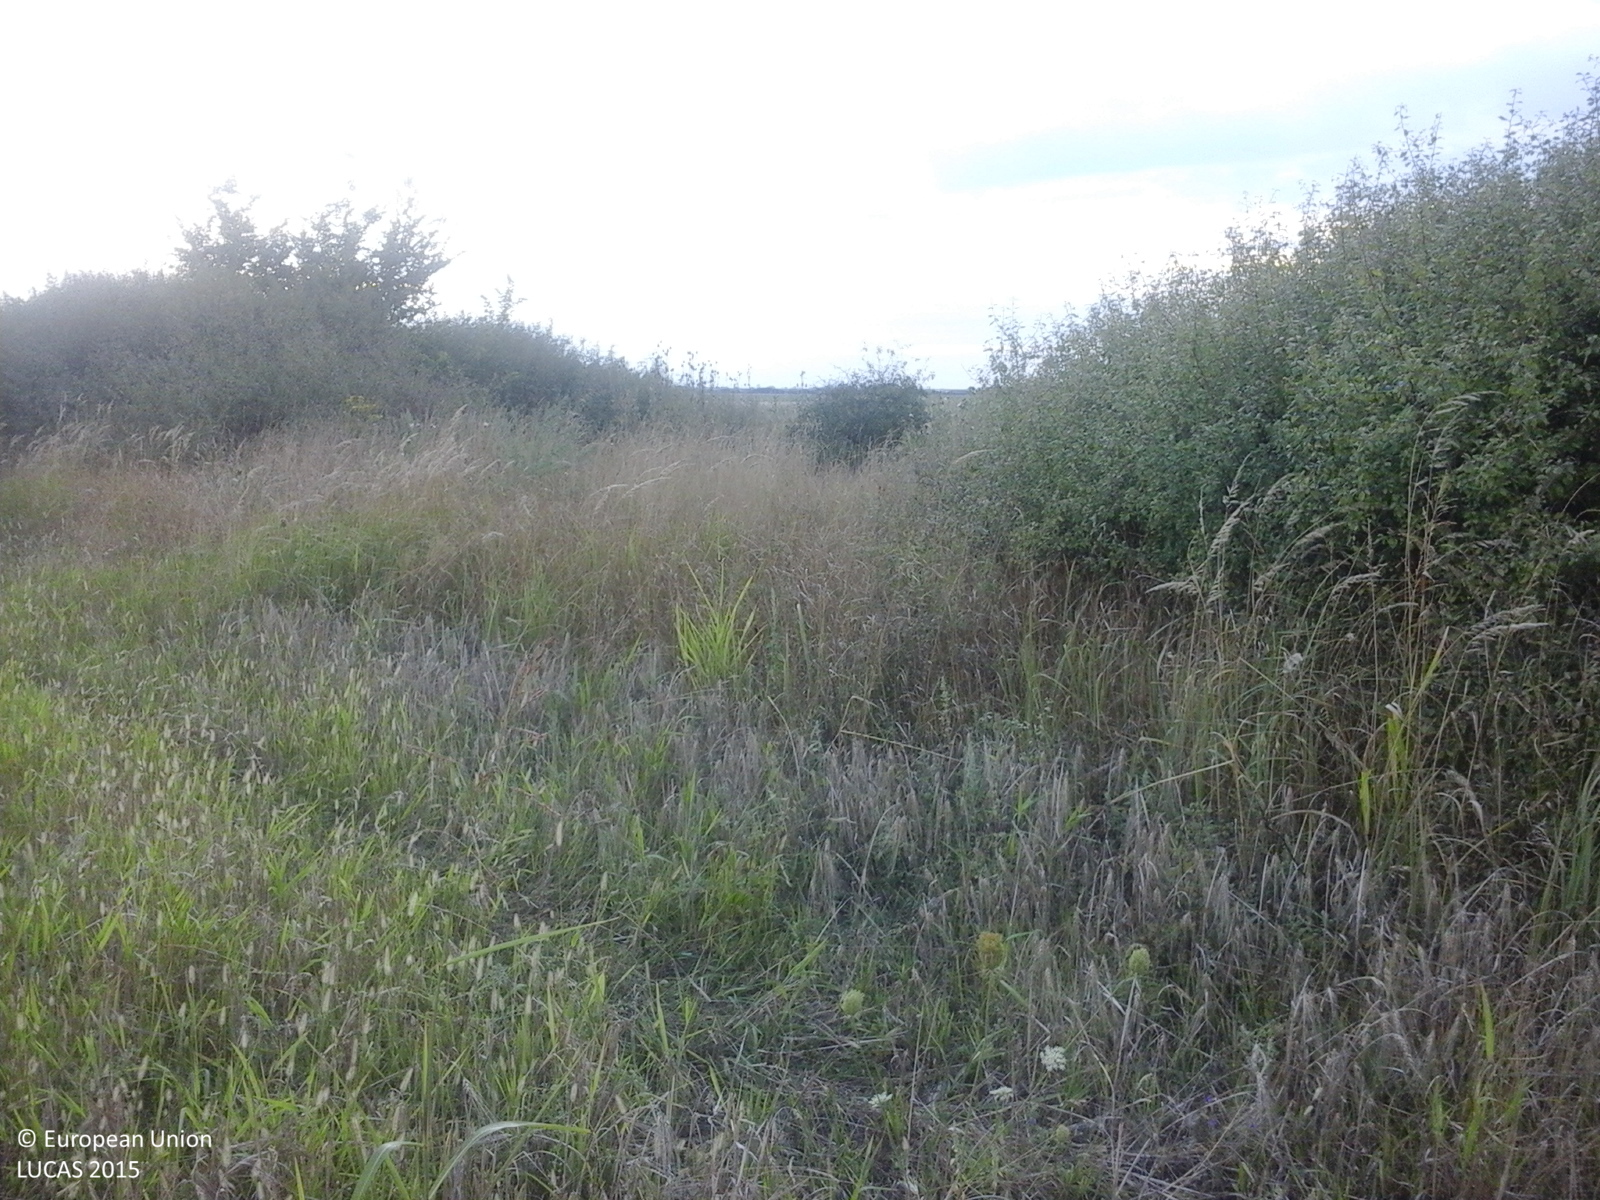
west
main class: Cropland
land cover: Common wheat
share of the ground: 50 - 75 %
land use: Agriculture (excluding fallow land and kitchen gardens)
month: August
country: RO
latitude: 45.3407
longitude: 21.2201
